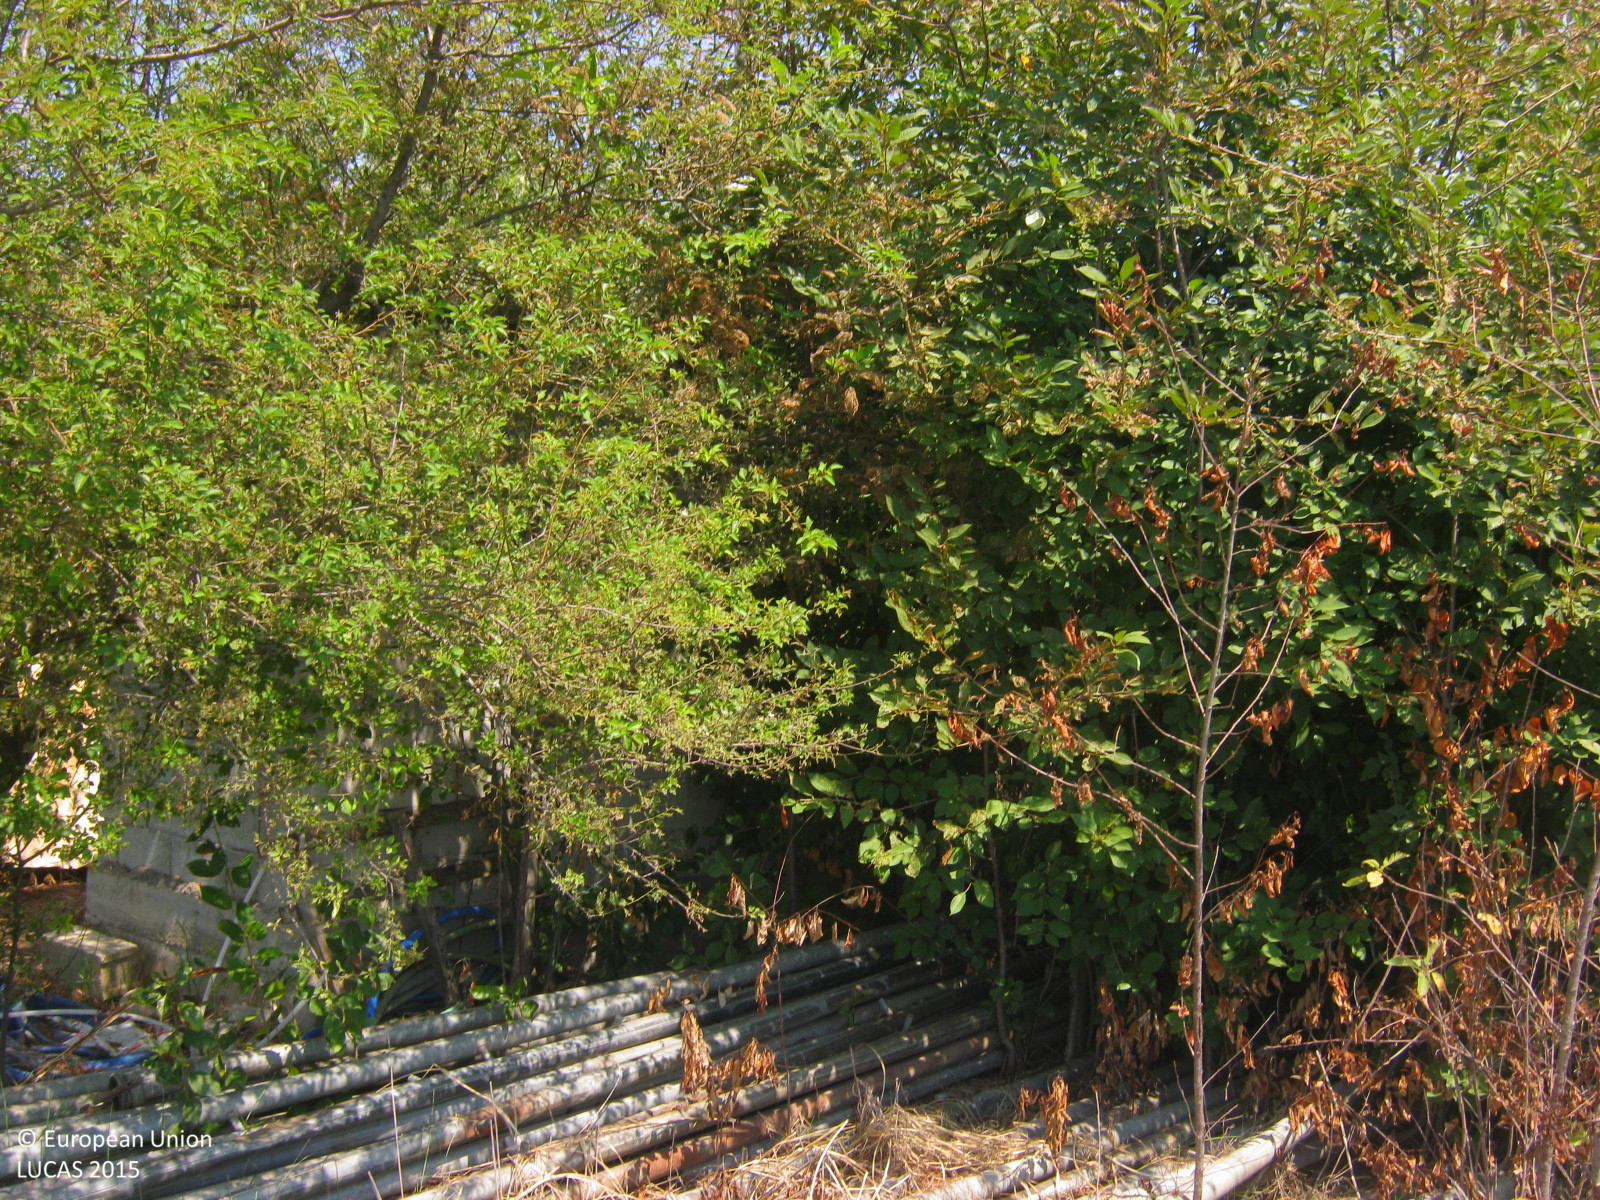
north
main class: Cropland
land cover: Cotton
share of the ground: > 75 %
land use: Agriculture (excluding fallow land and kitchen gardens)
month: July
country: GR
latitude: 41.0633
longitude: 25.1702
